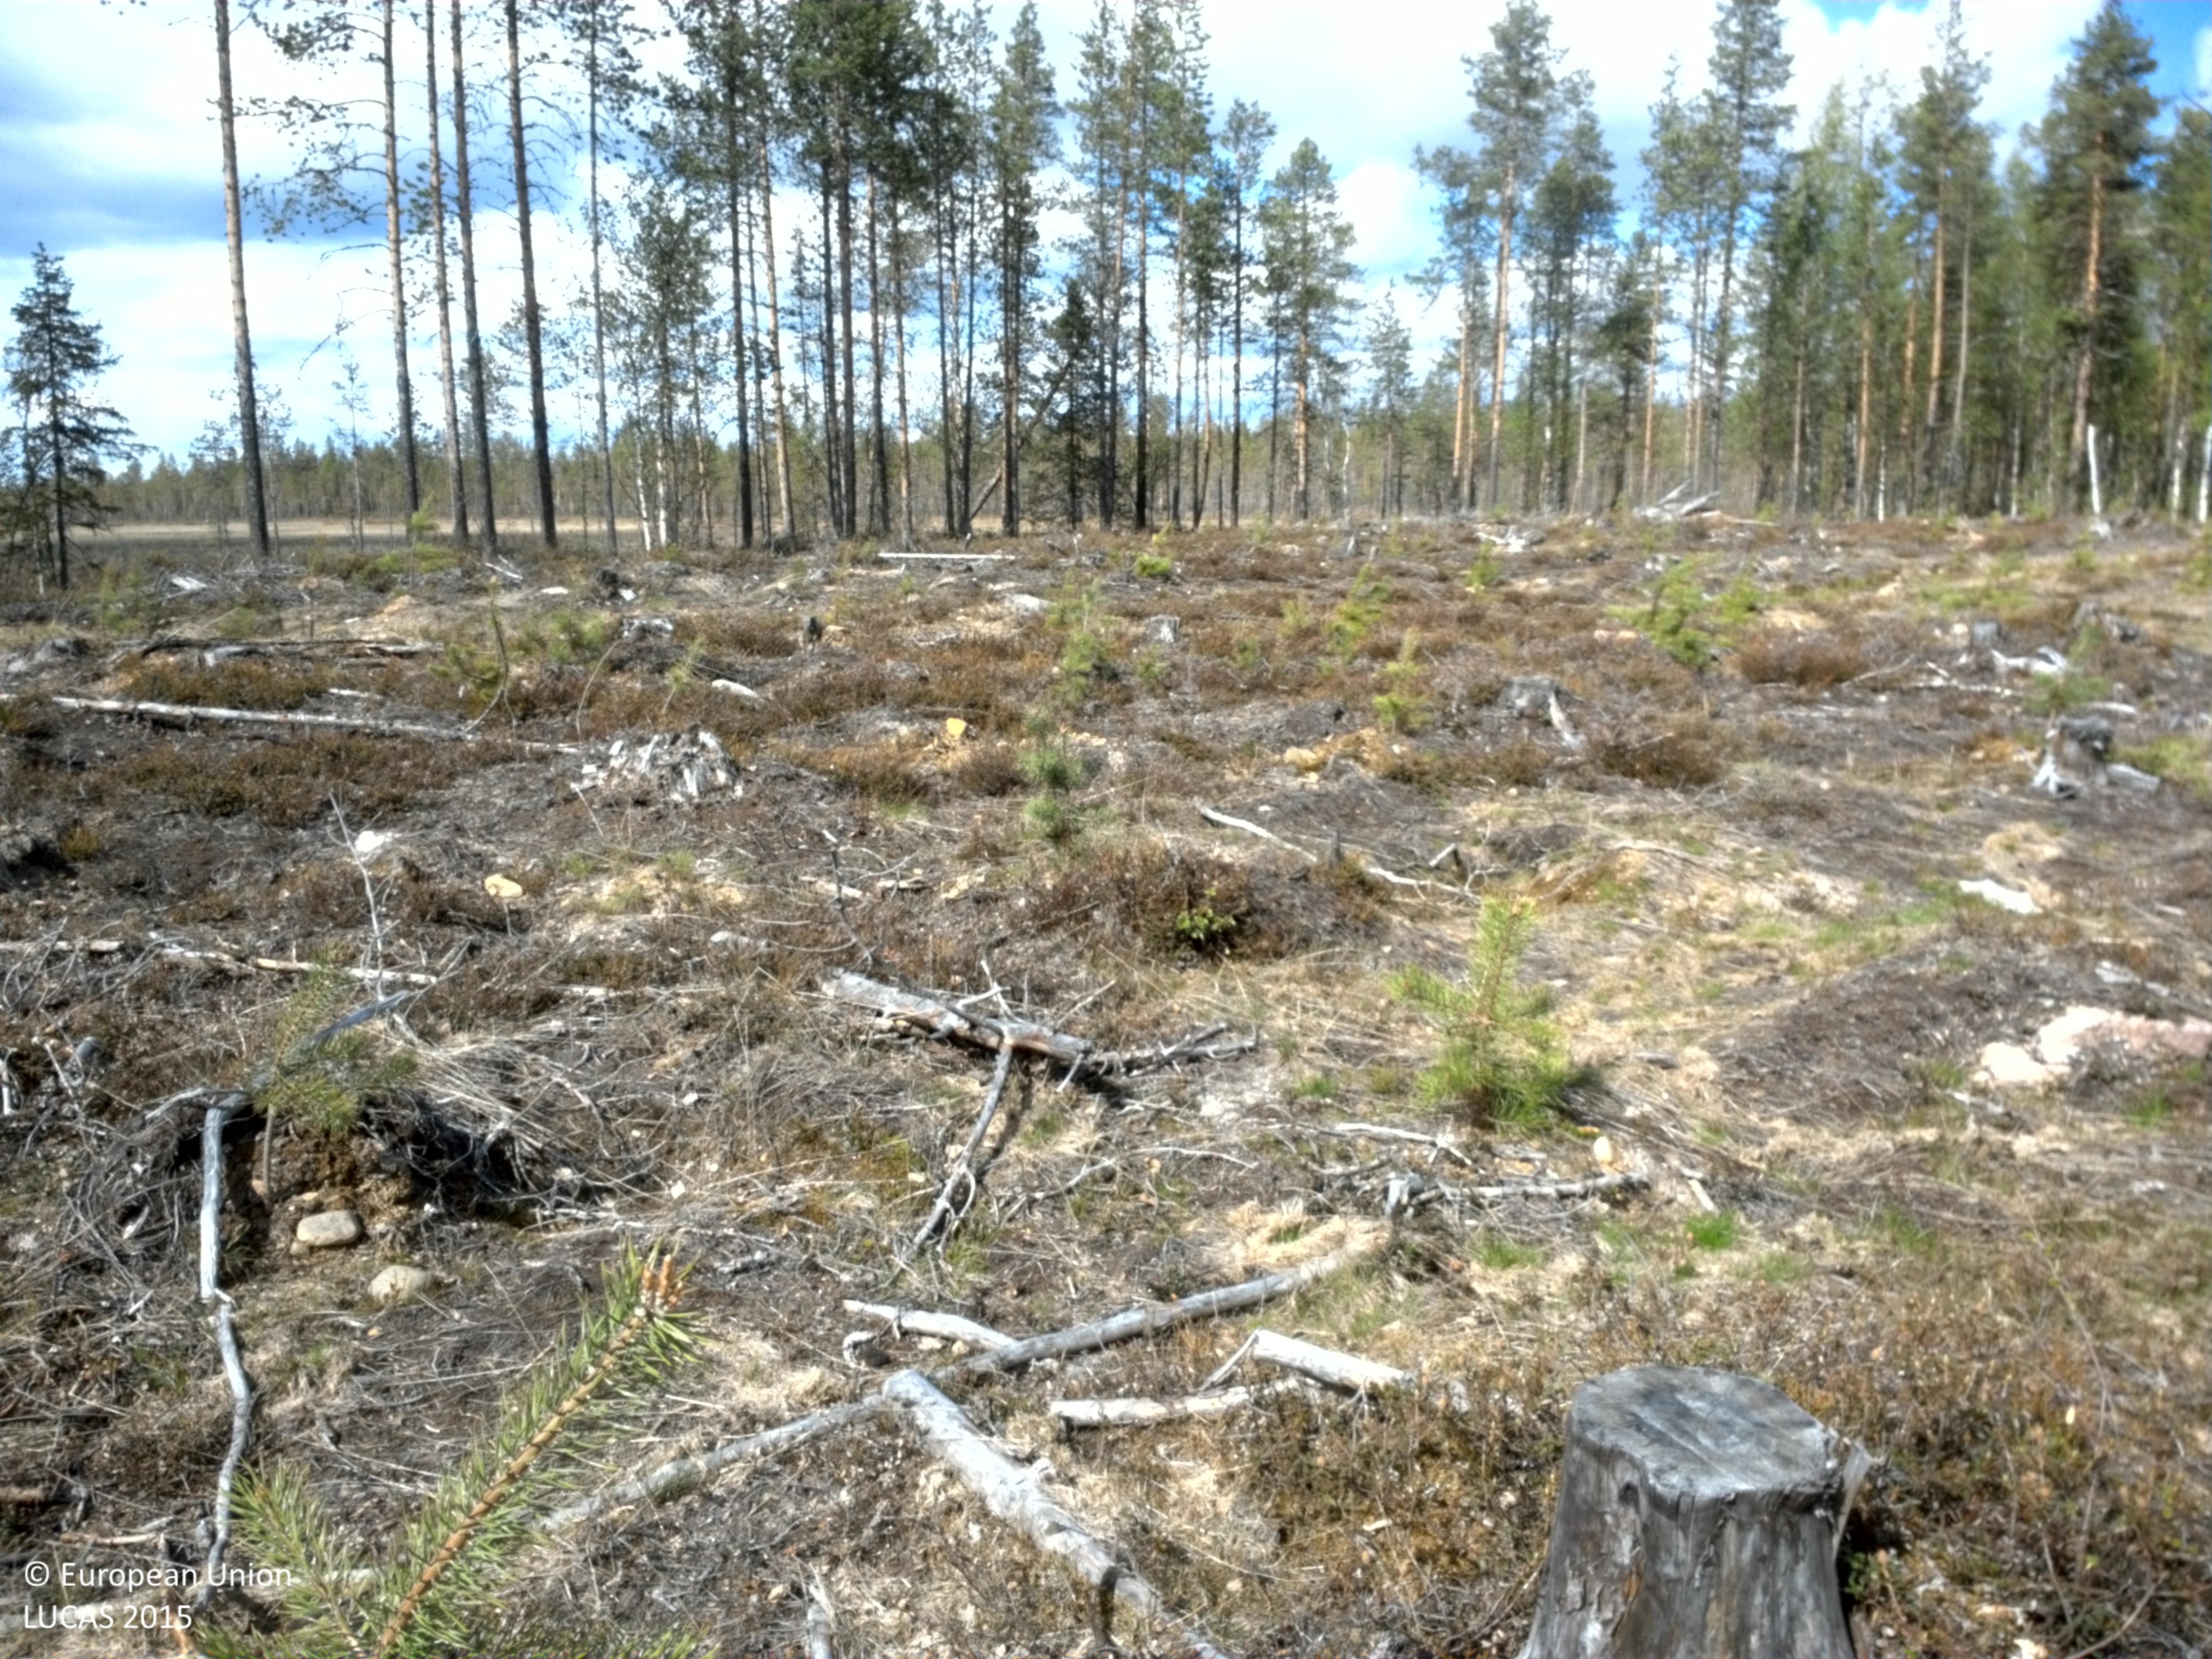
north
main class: Shrubland
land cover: Shrubland with sparse tree cover
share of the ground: 10 - 25 %
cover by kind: herbaceous plants 55 %, unconsolidated bare surface 25 %, shrubs 15 %, coniferous forest trees 5 %
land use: Forestry
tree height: < 5 m
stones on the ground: < 10 %
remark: Clear cut
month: June
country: SE
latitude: 66.9747
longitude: 21.3421
